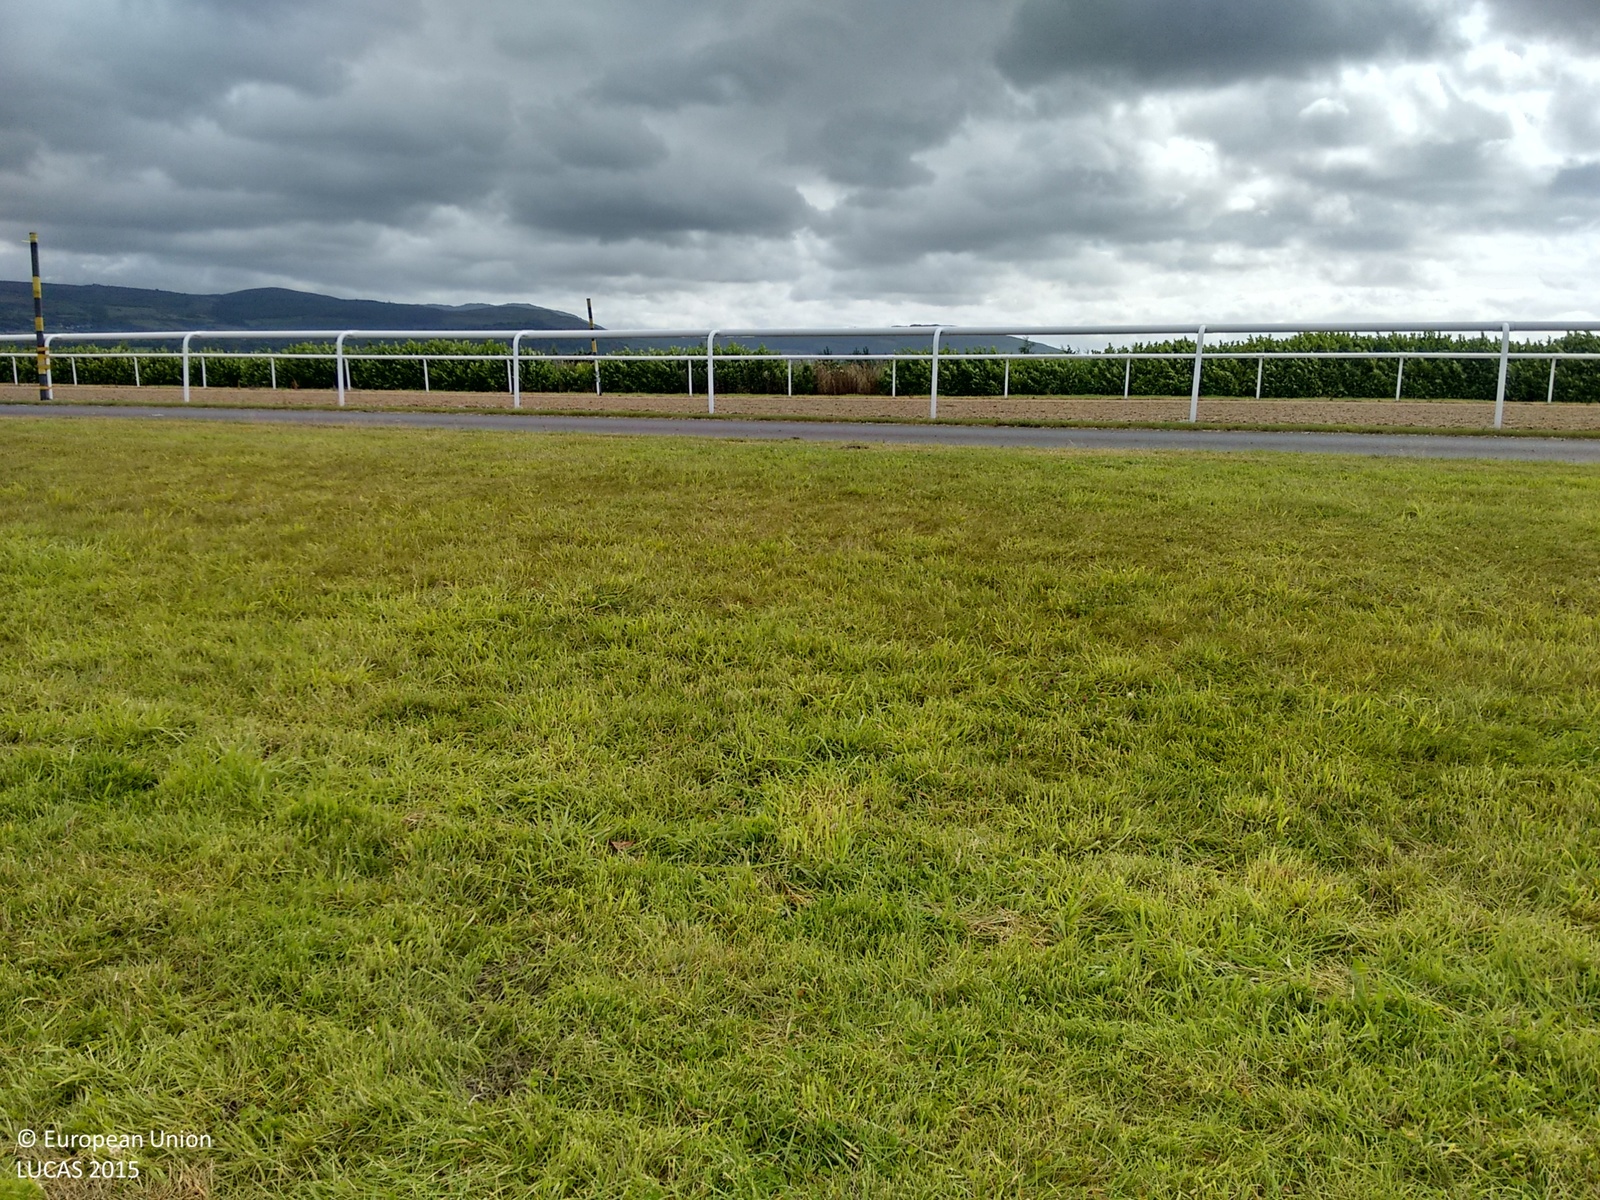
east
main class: Grassland
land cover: Grassland without tree/shrub cover
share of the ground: > 75 %
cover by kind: herbaceous plants 100 %
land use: Amenities, museums, leisure
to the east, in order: Grassland without tree/shrub cover; Artificial constructions in urban areas; Grass margins; Managed hedges; Spontaneously vegetated surfaces; Fences; Other mixed woodland; Fences; Ditches and canals; Grass margins; Lines of trees; Inland marshes
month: August
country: IE
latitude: 54.0213
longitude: -6.3776
